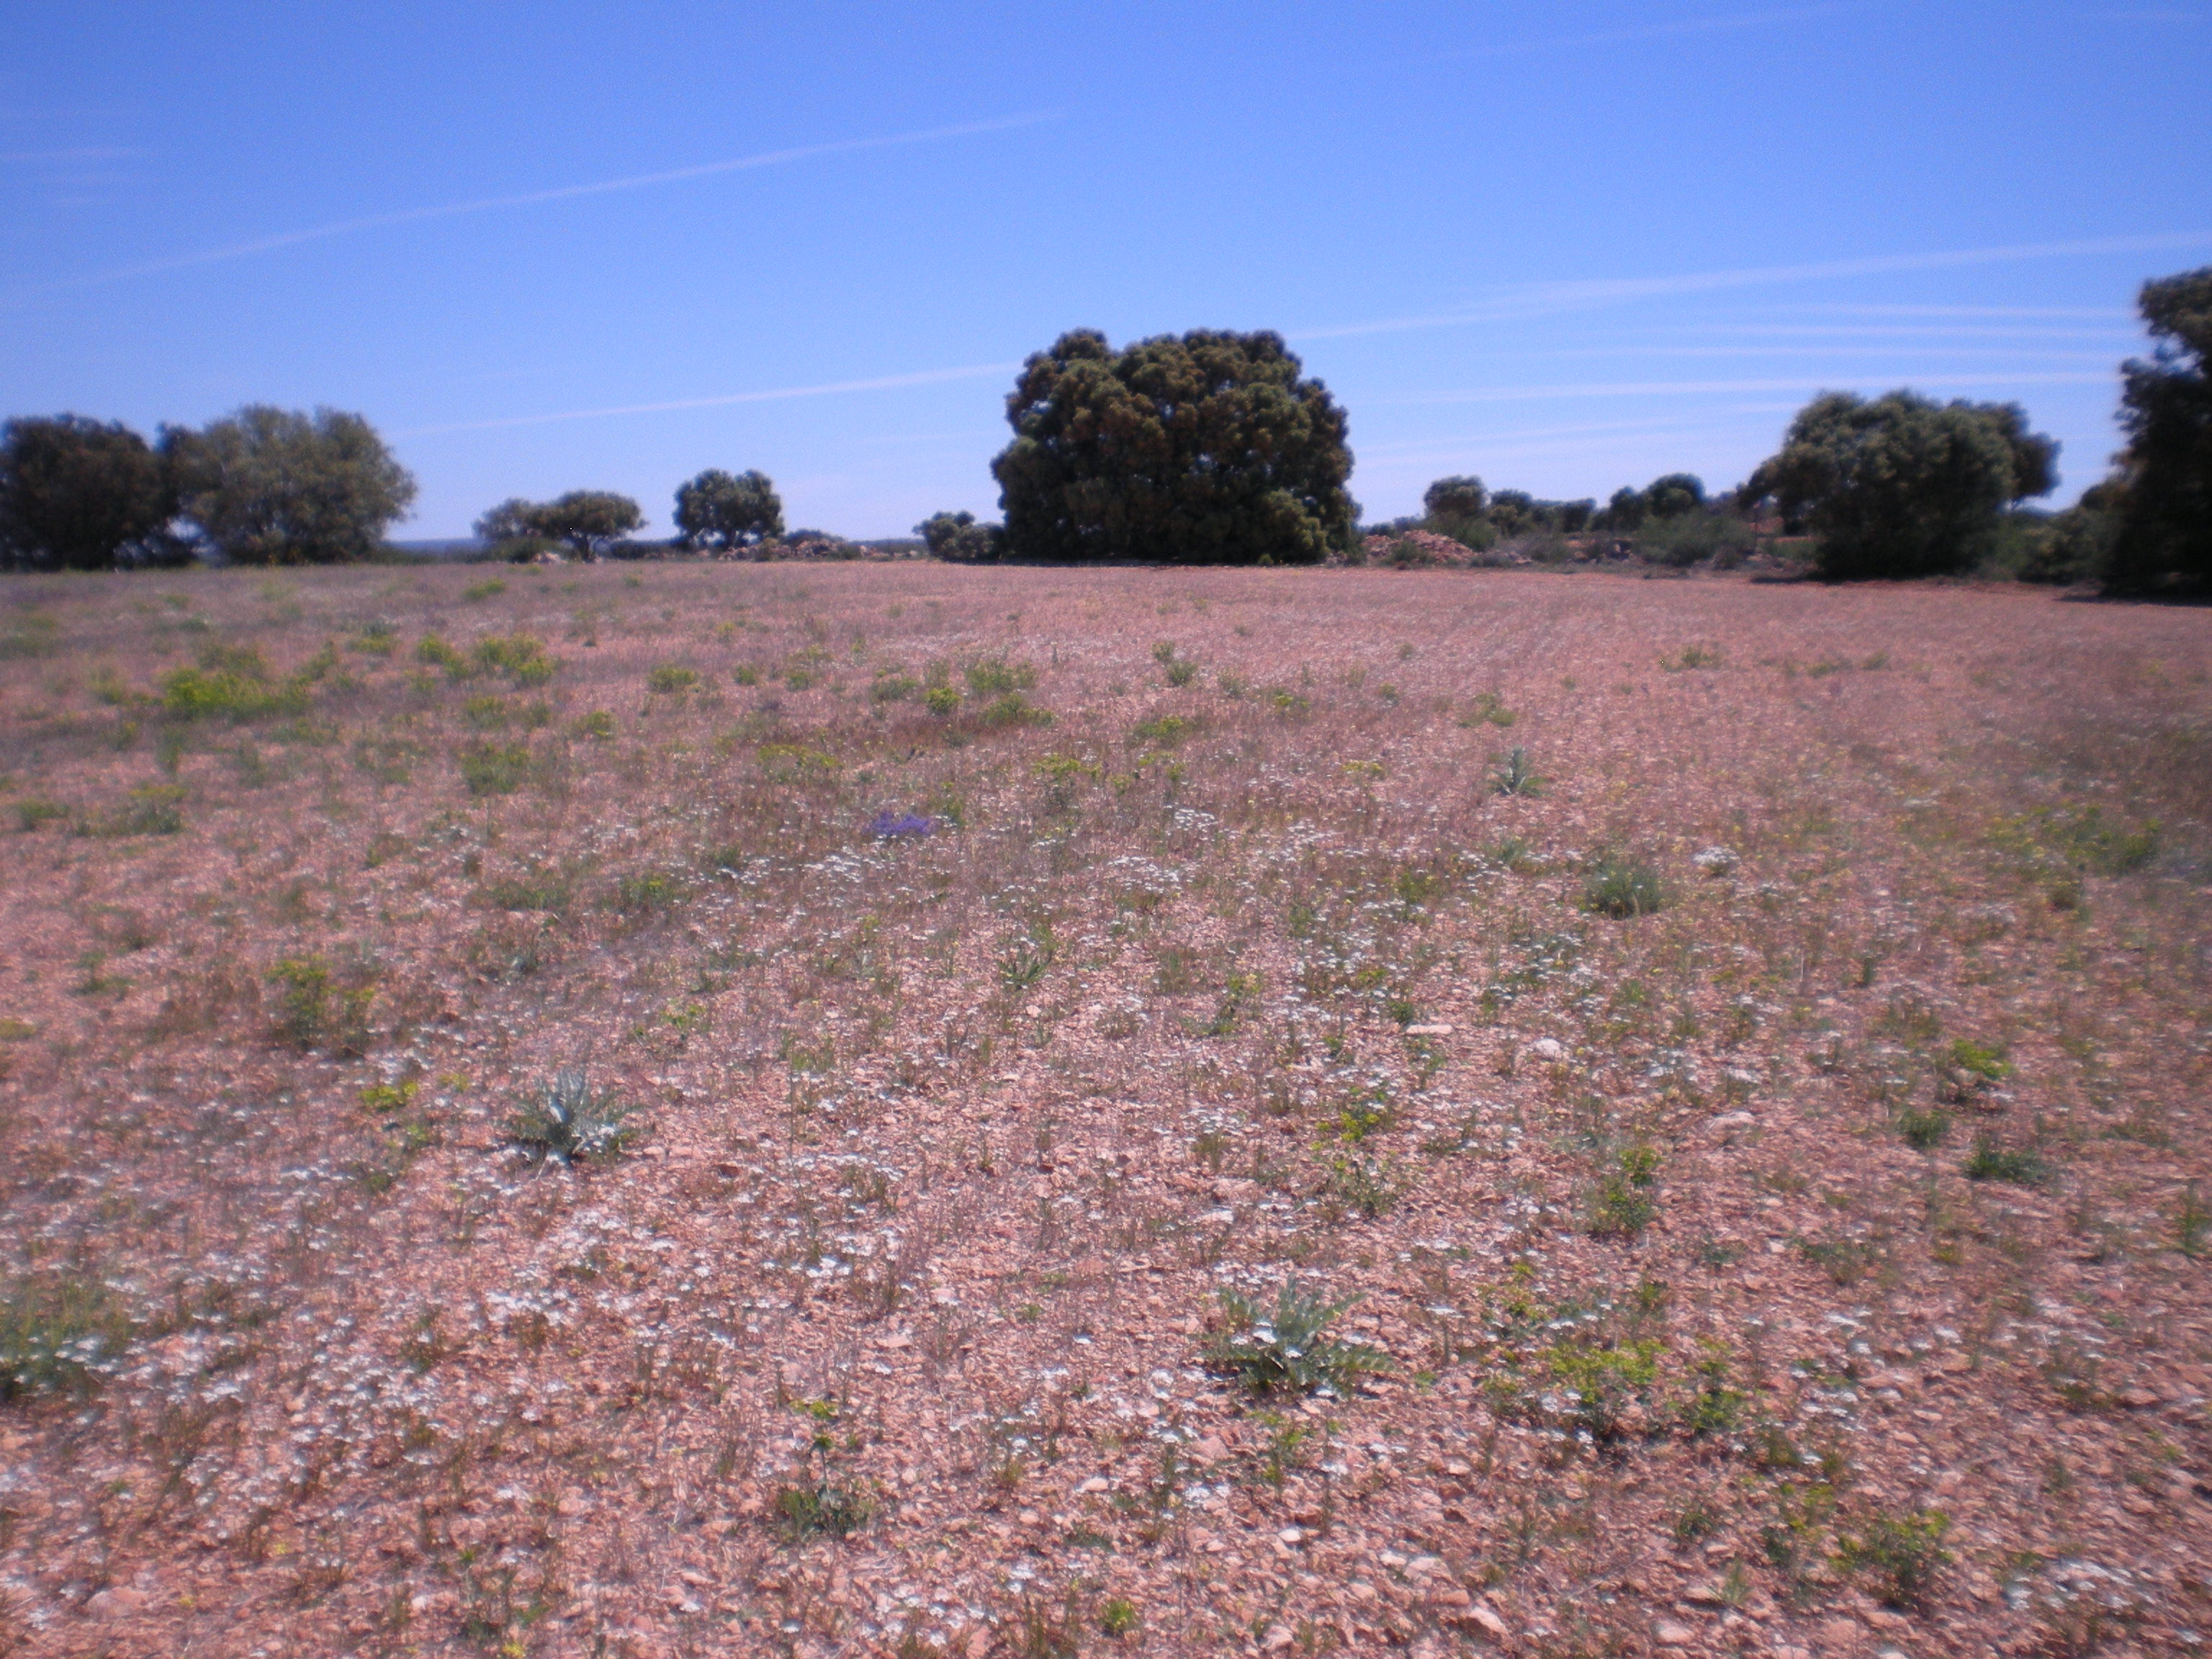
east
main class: Grassland
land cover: Spontaneously vegetated surfaces
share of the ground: > 75 %
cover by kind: unconsolidated bare surface 70 %, herbaceous plants 30 %
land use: Fallow land
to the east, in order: Spontaneously vegetated surfaces; Single bushes/trees; Grassland without tree/shrub cover; Fences; Other bare soil; Grass margins; Tracks; Grass margins; Broadleaved woodland
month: May
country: ES
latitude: 38.9957
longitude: -2.9995
